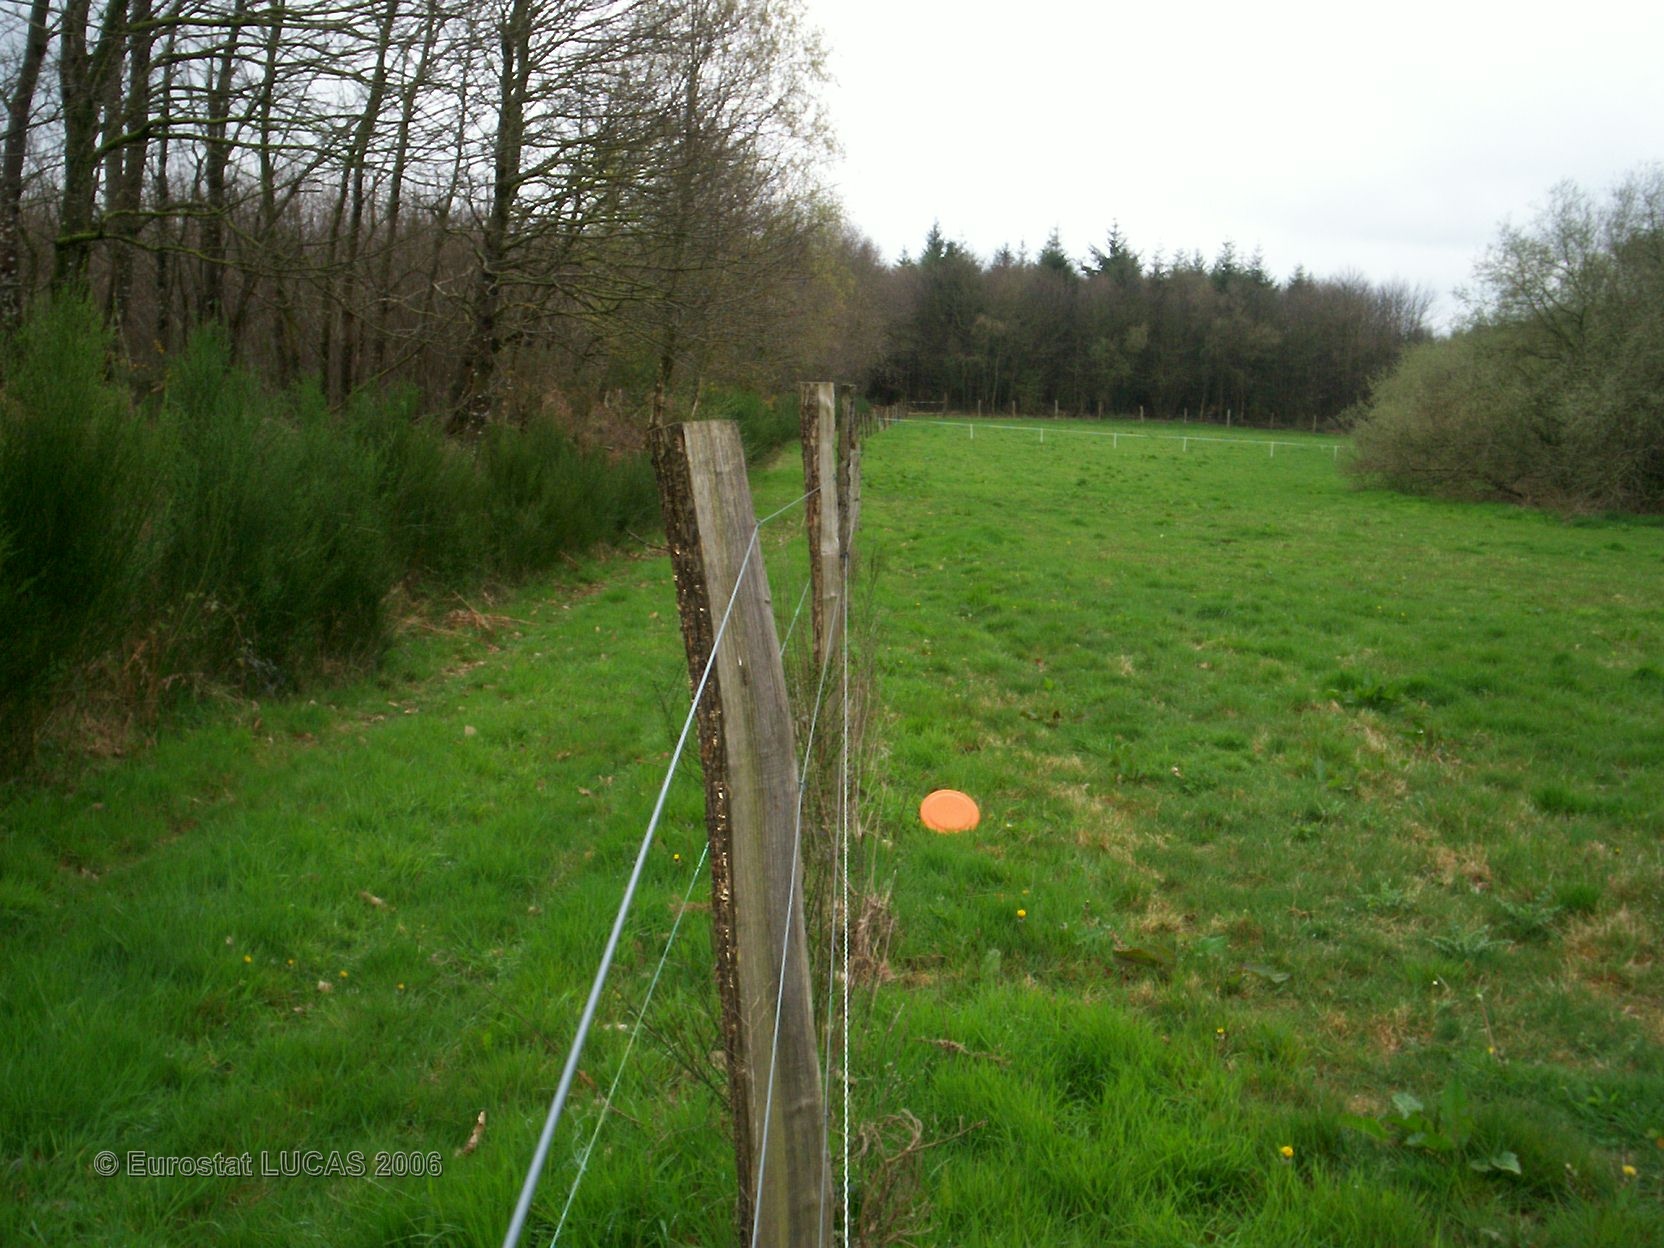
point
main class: Grassland
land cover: Grassland without tree/shrub cover
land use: Agriculture (excluding fallow land and kitchen gardens)
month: April
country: FR
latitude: 47.8114
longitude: -2.8712
